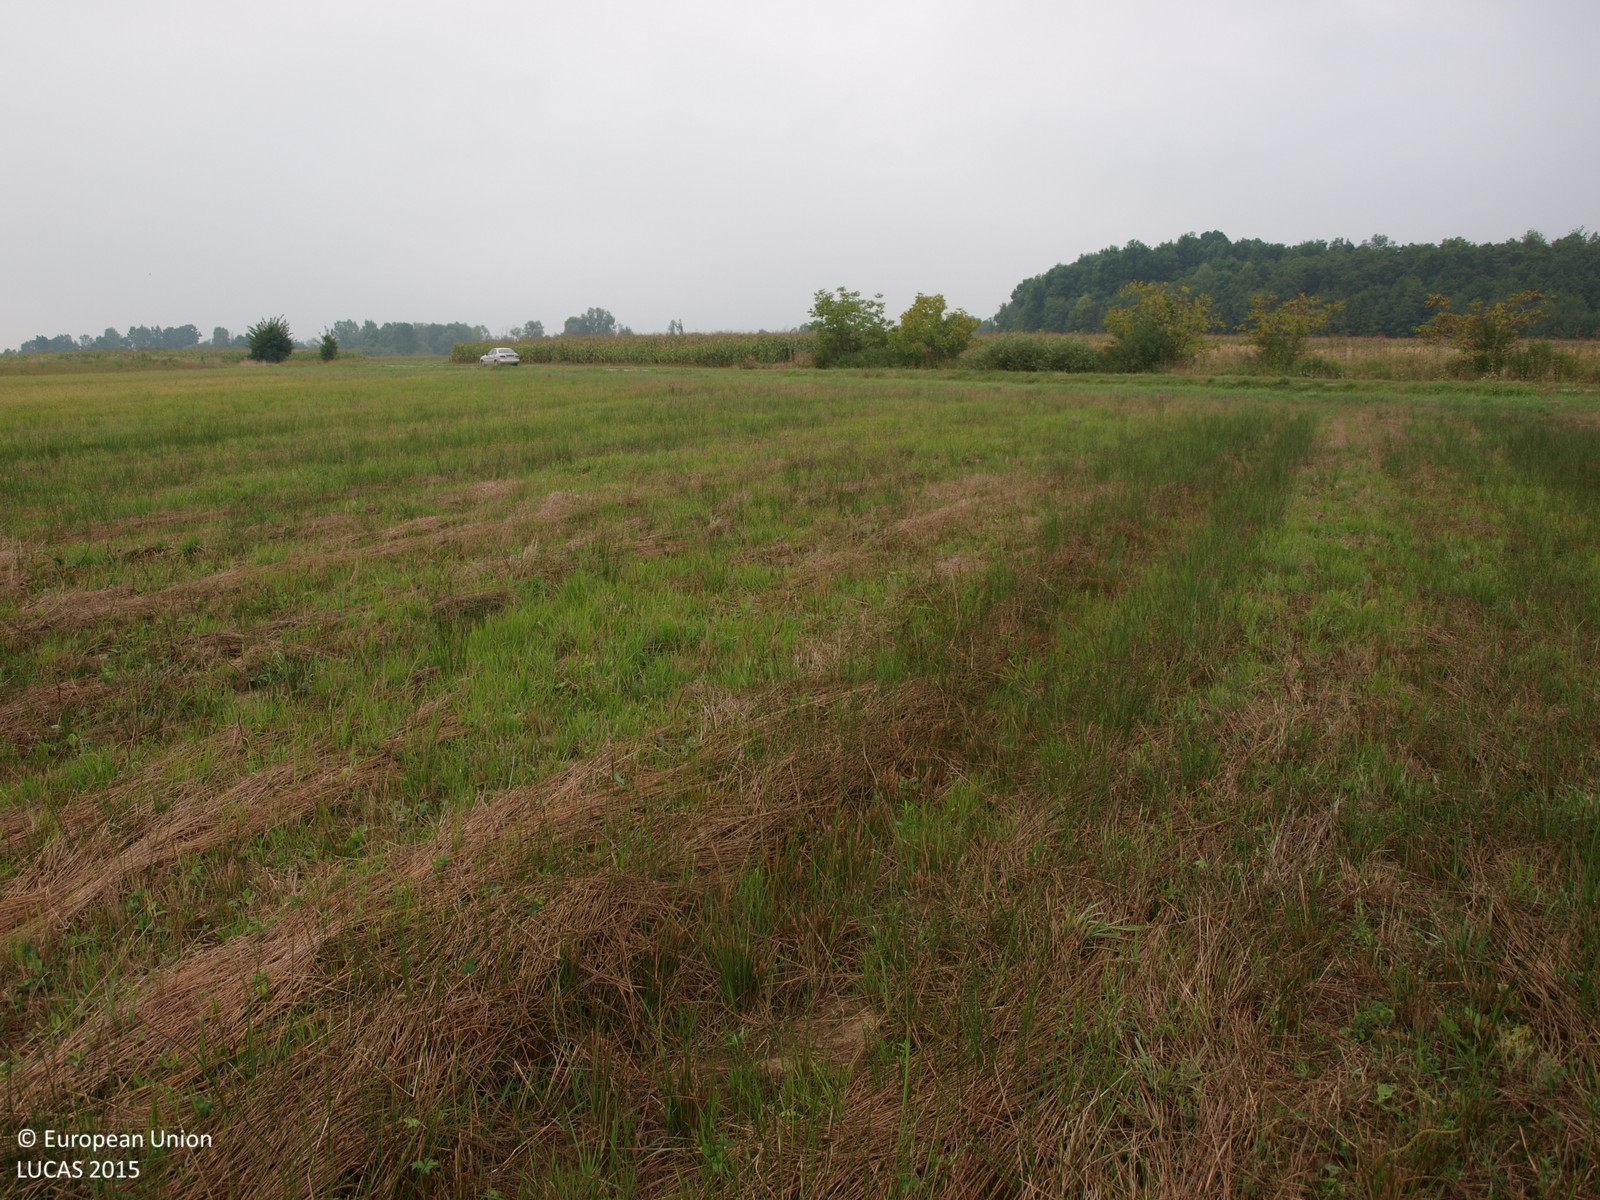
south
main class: Grassland
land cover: Grassland without tree/shrub cover
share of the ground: > 75 %
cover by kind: herbaceous plants 100 %
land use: Agriculture (excluding fallow land and kitchen gardens)
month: August
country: HR
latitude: 45.7703
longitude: 16.2609
